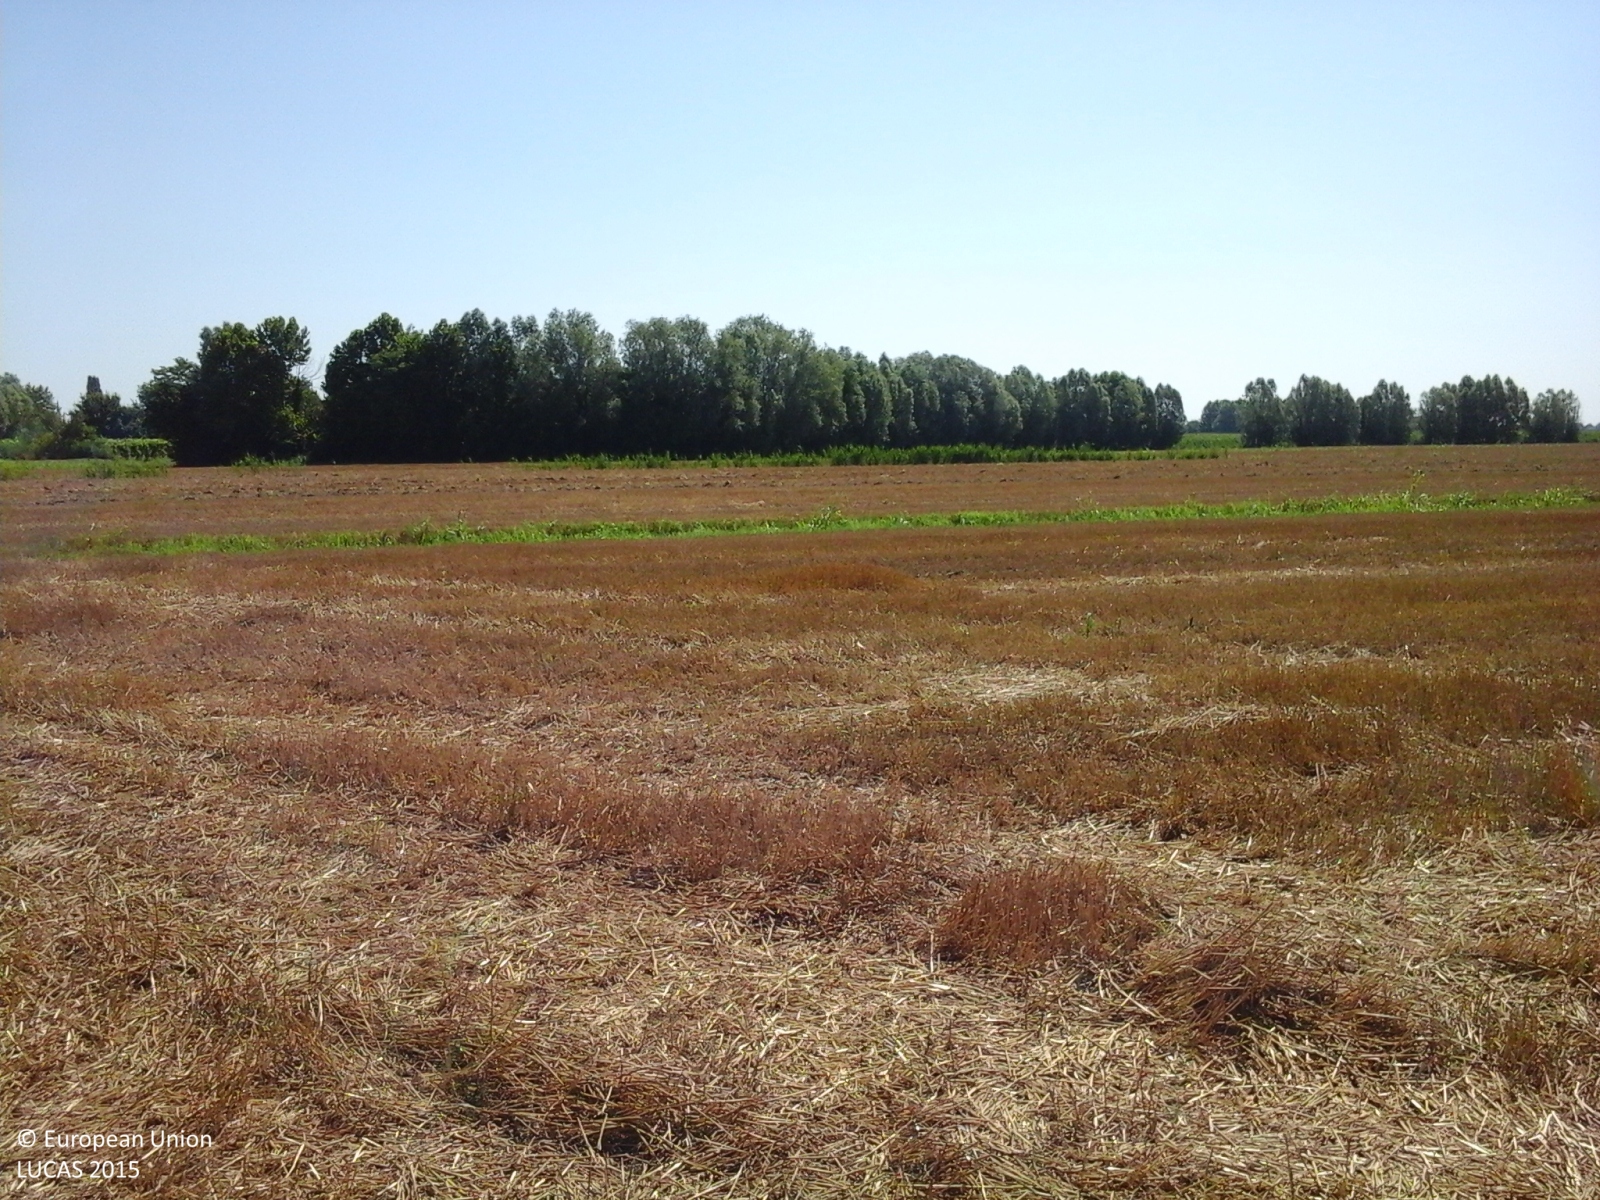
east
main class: Cropland
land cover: Common wheat
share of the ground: > 75 %
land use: Agriculture (excluding fallow land and kitchen gardens)
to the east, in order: Common wheat; Ditches and canals; Common wheat; Ditches and canals; Common wheat; Grass margins; Managed hedges; Ditches and canals; Managed hedges; Grassland with sparse tree/shrub cover
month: July
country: IT
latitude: 45.6947
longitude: 12.3467
